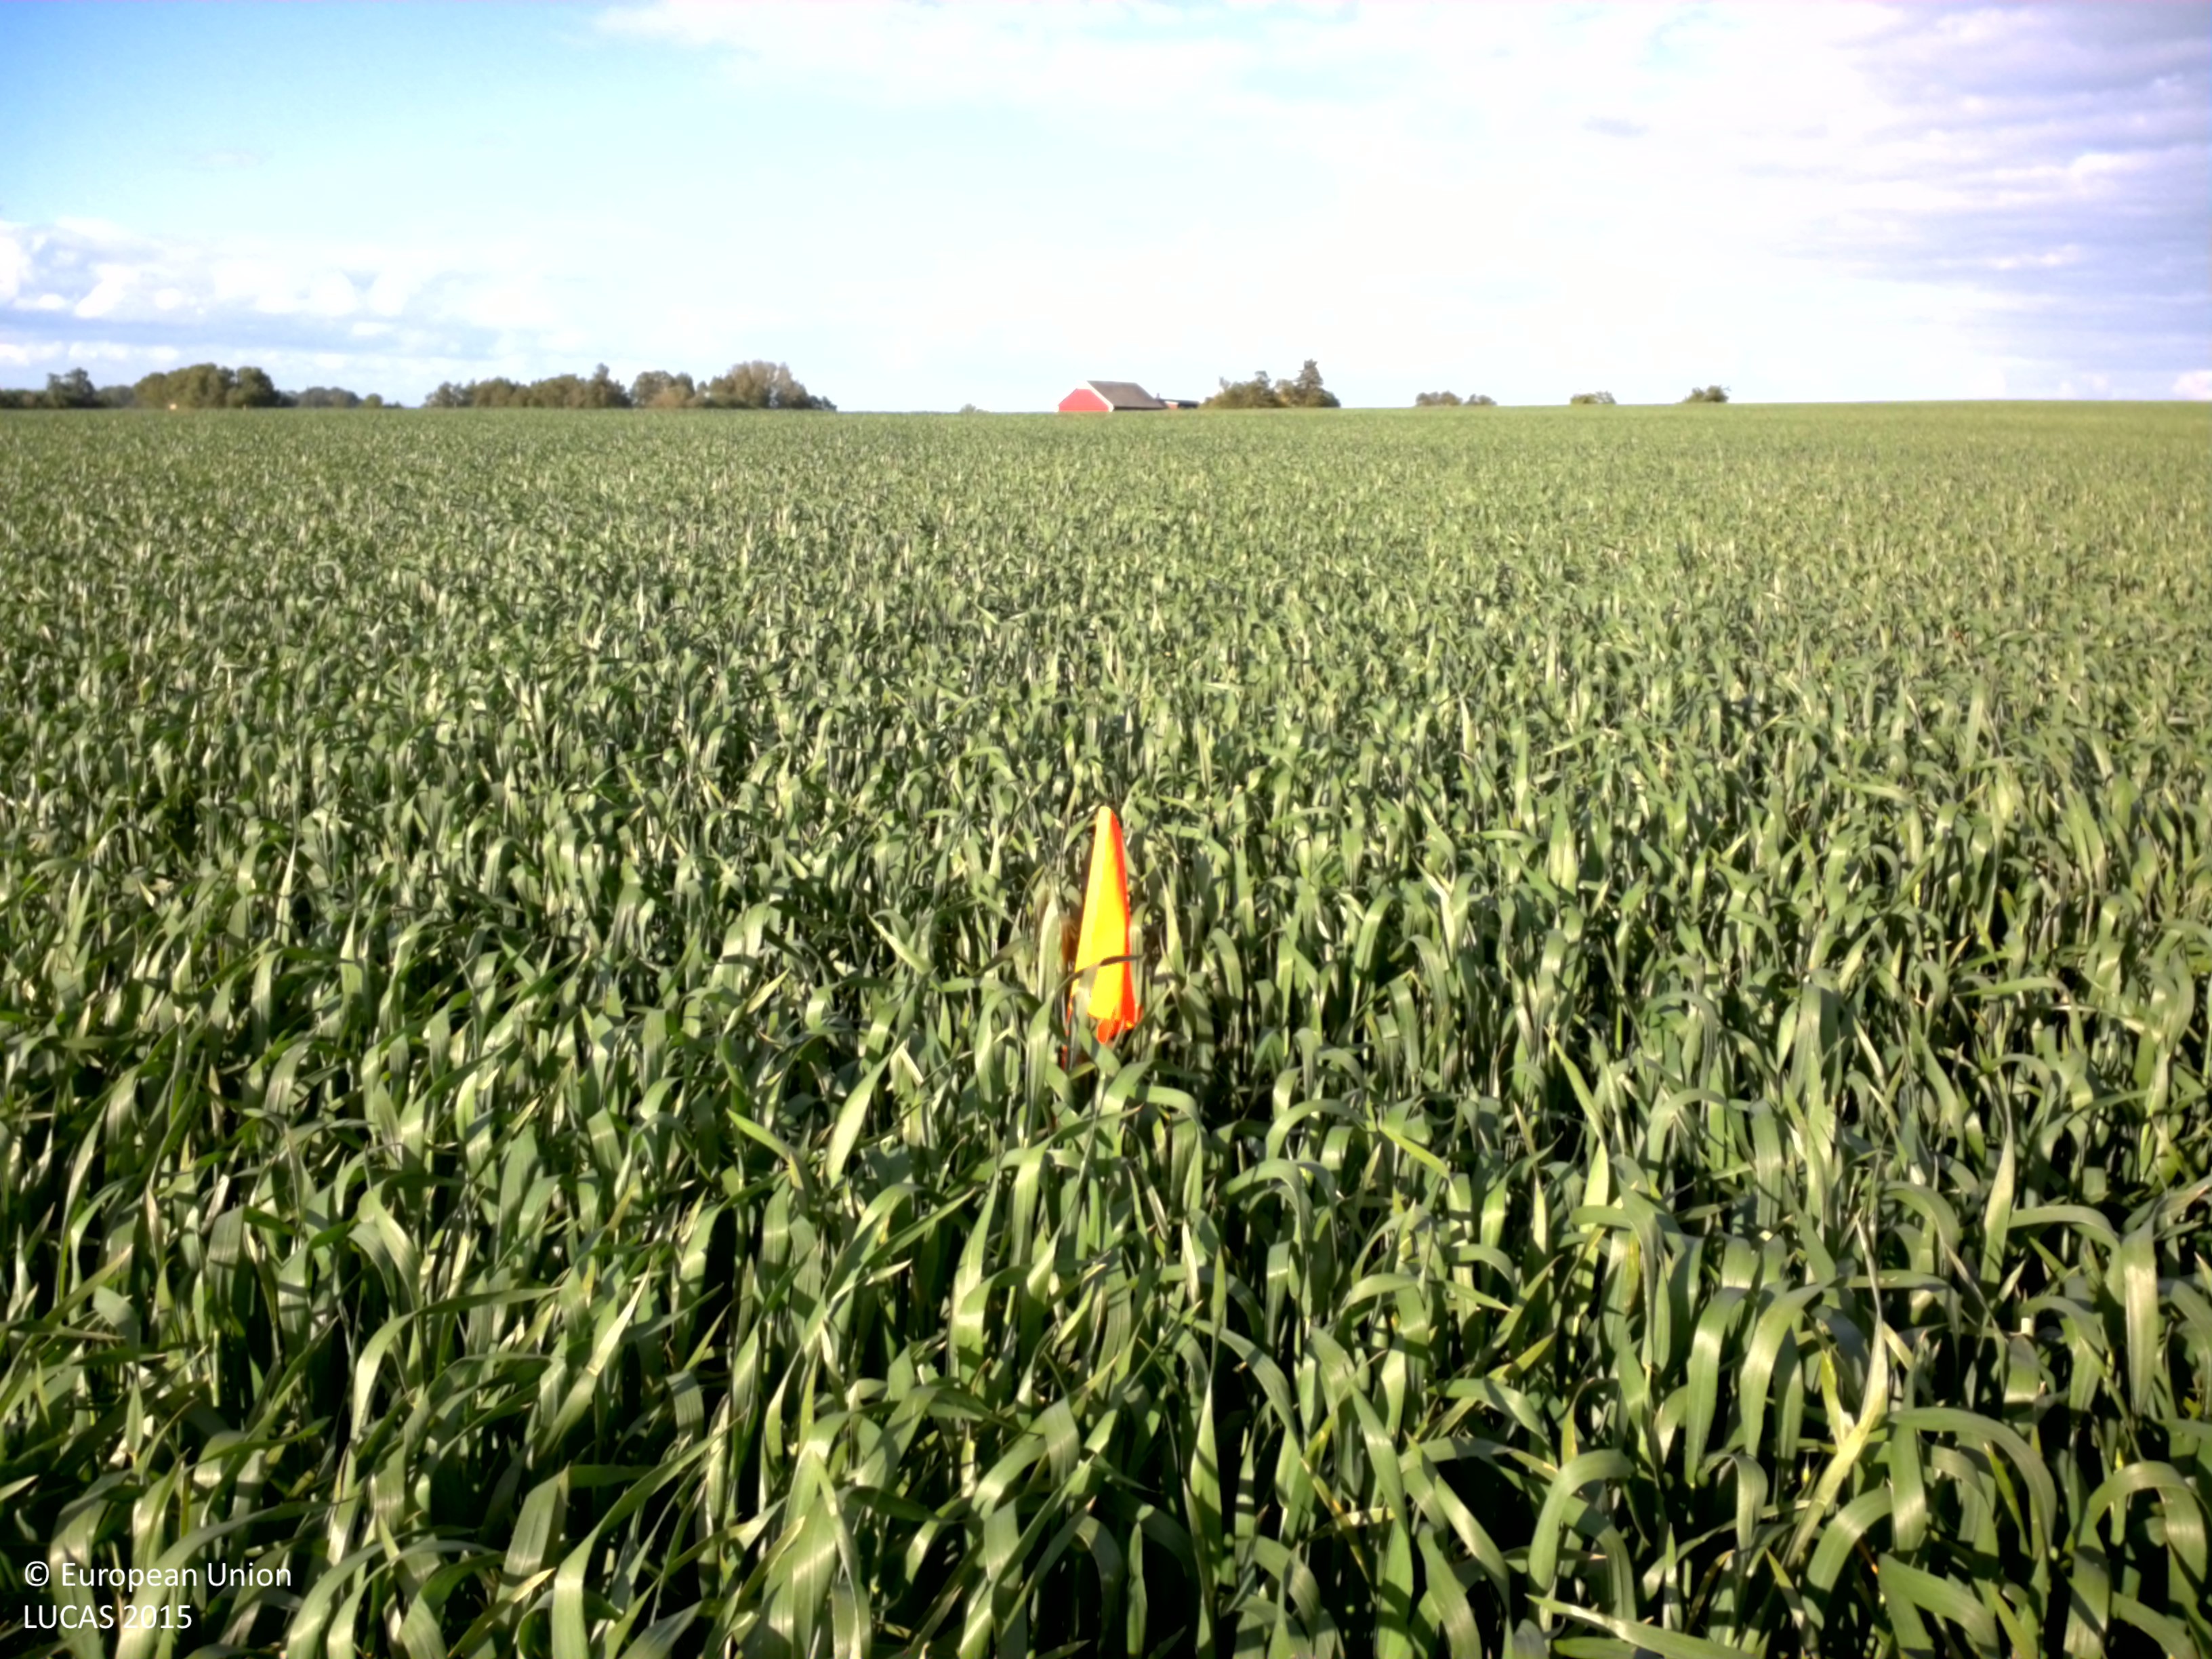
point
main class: Cropland
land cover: Common wheat
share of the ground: > 75 %
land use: Agriculture (excluding fallow land and kitchen gardens)
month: June
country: SE
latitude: 55.7919
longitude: 13.0441
